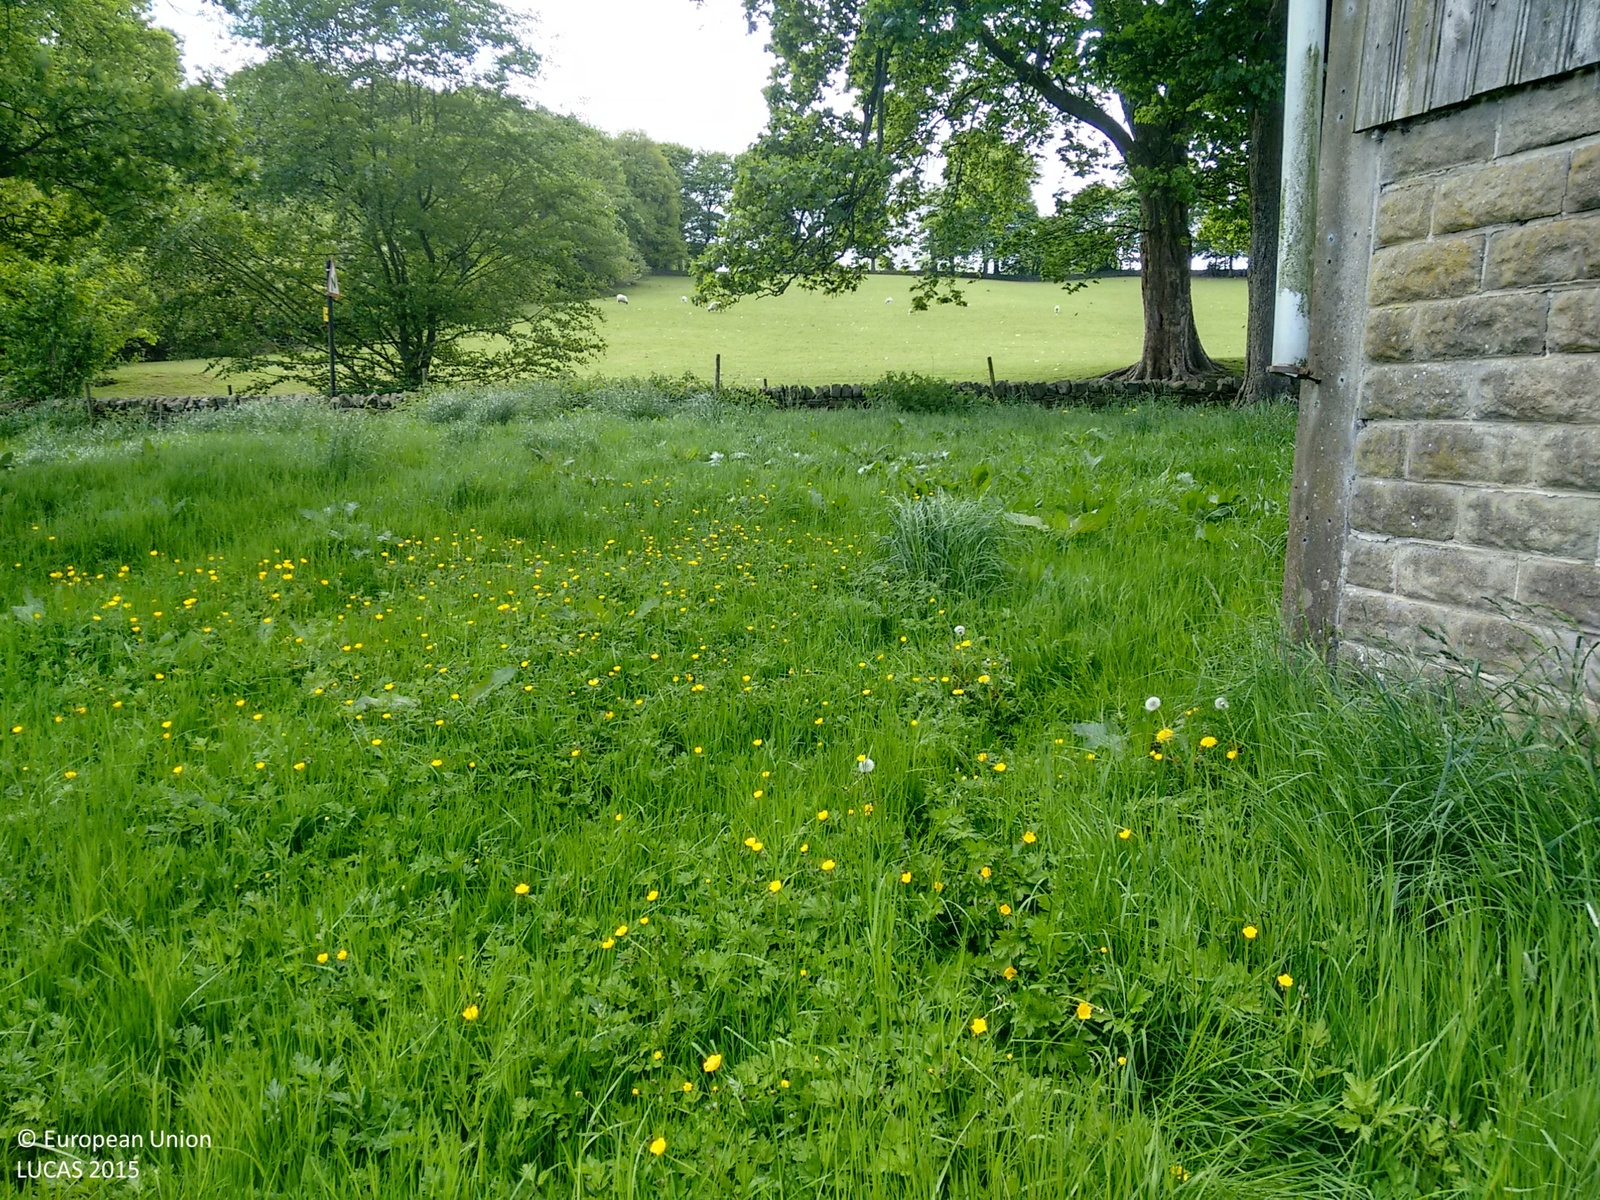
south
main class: Grassland
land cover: Grassland without tree/shrub cover
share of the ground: > 75 %
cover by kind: herbaceous plants 100 %
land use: Agriculture (excluding fallow land and kitchen gardens)
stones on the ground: < 10 %
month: May
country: GB
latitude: 53.3564
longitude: -1.5448
